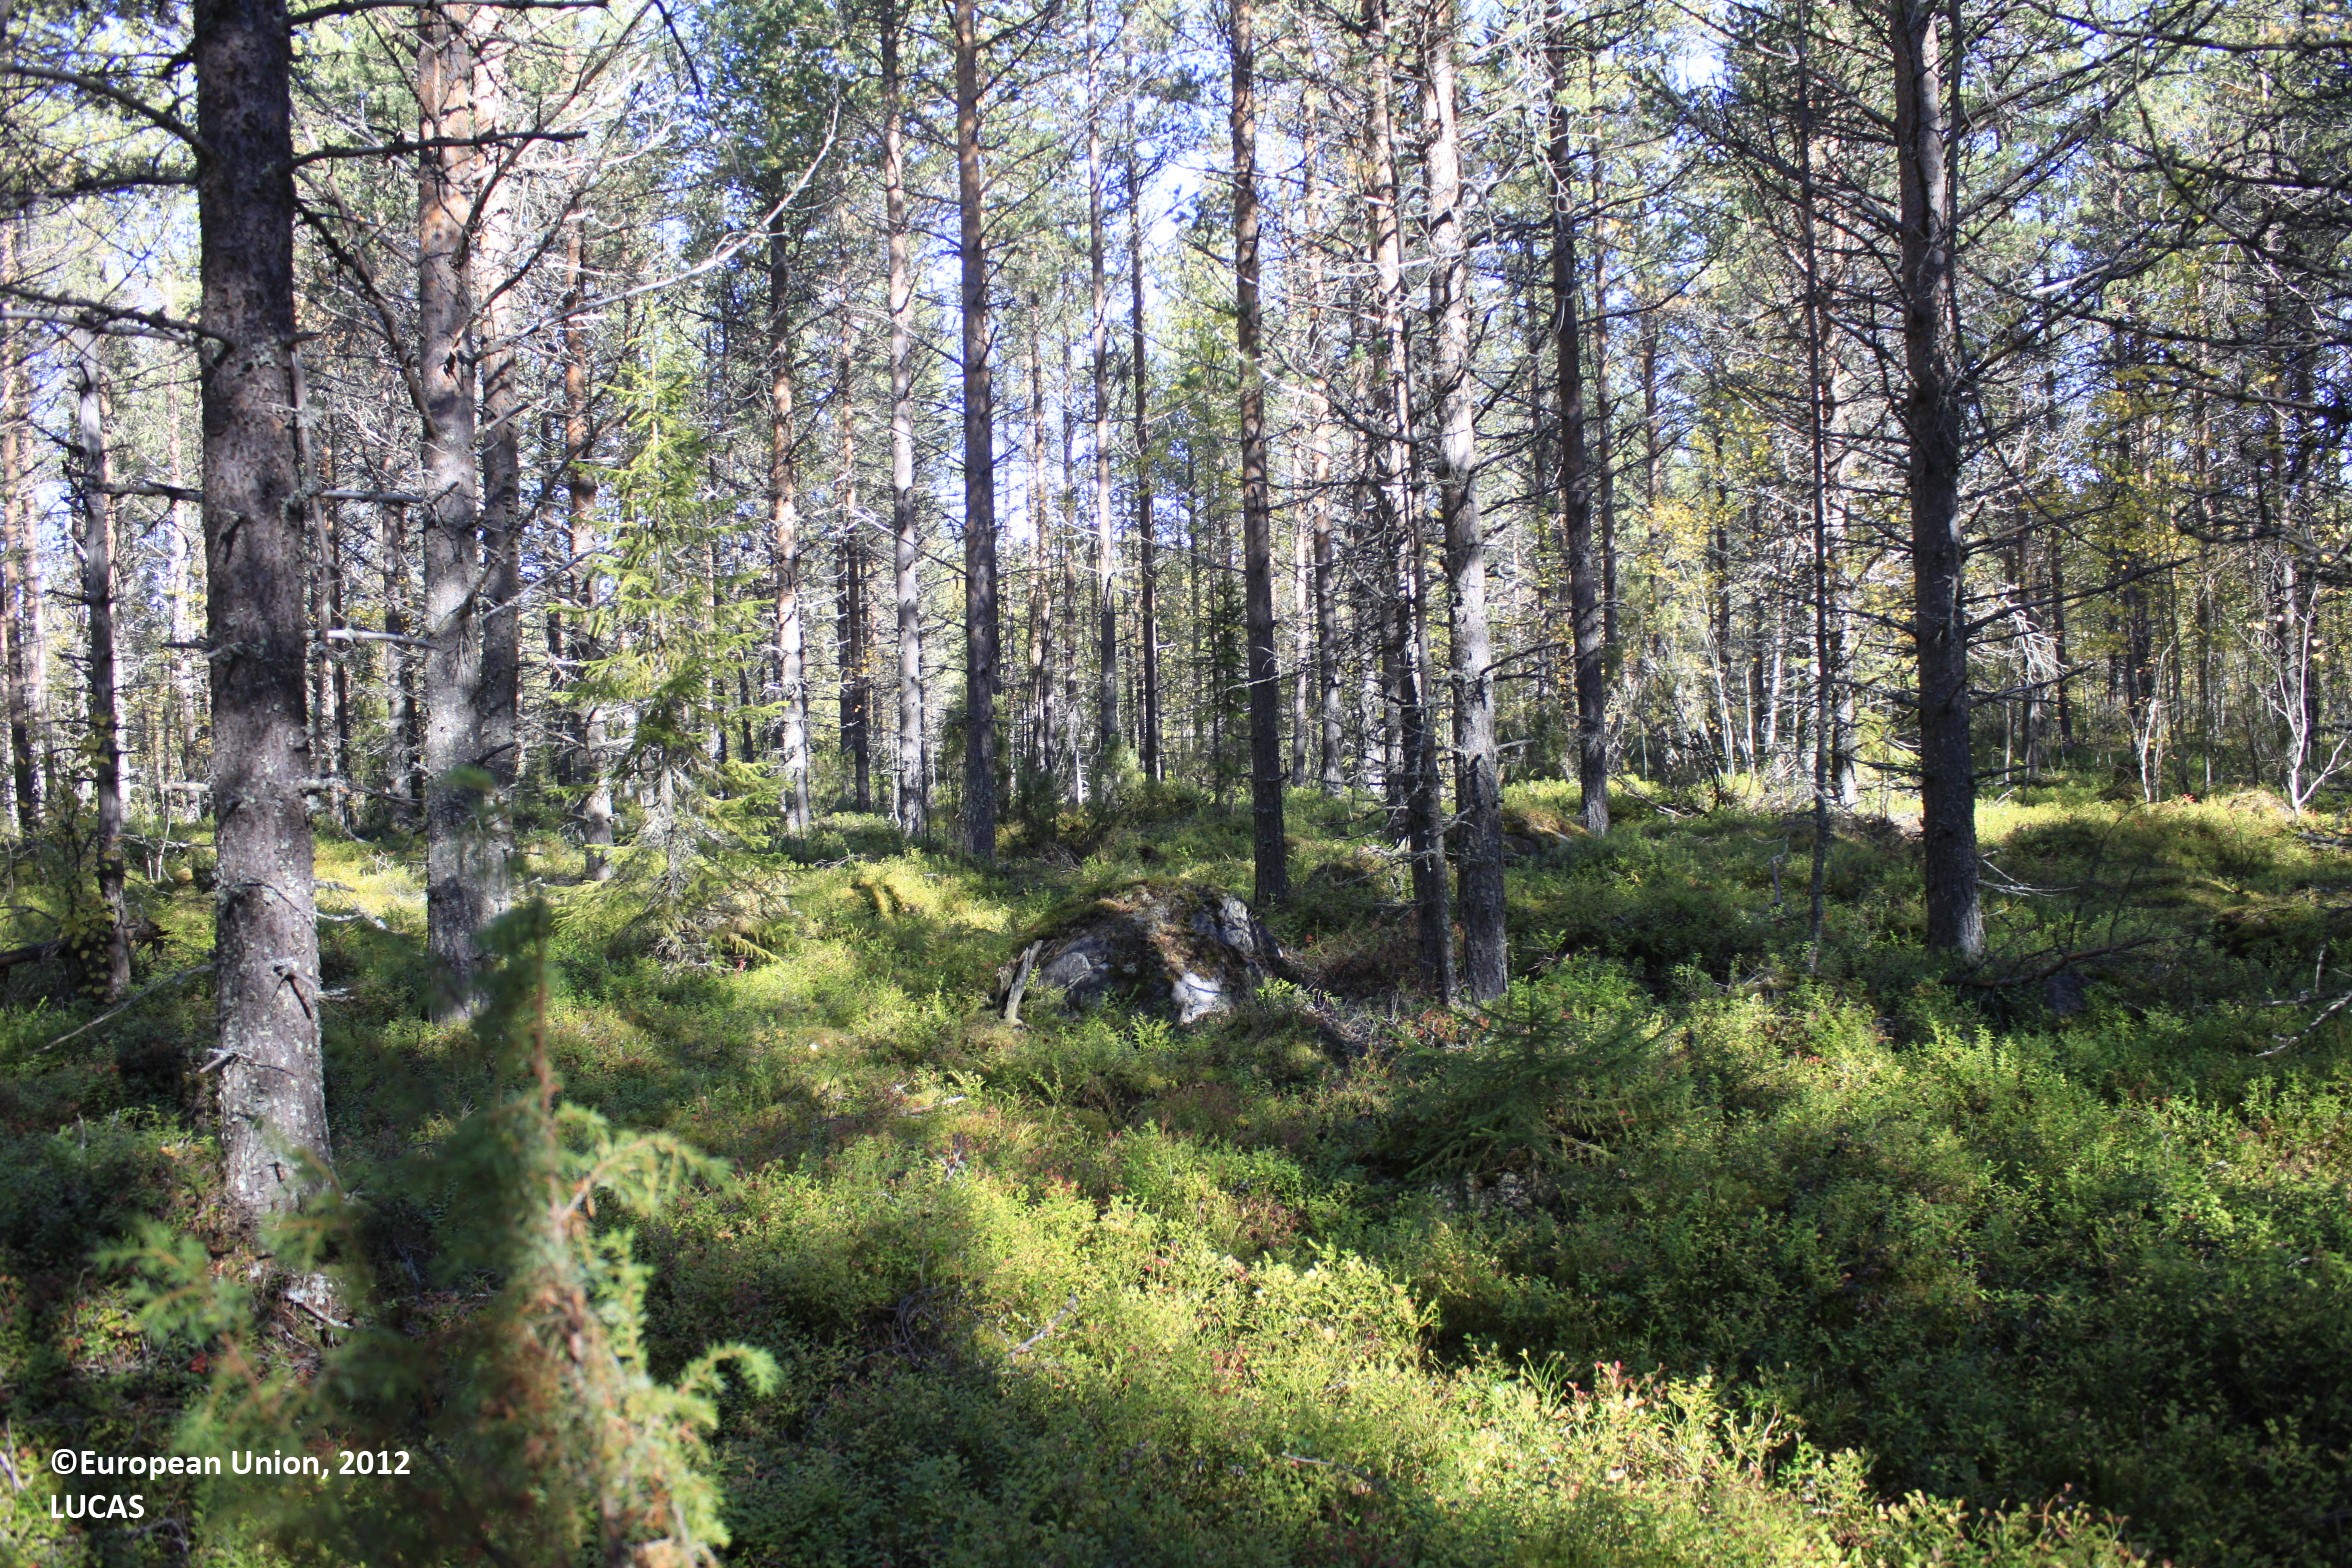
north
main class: Woodland
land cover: Pine dominated coniferous woodland
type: boreal forest
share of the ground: 25 - 50 %
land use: Forestry
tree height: > 5 m
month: September
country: FI
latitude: 65.8461
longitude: 26.8606
